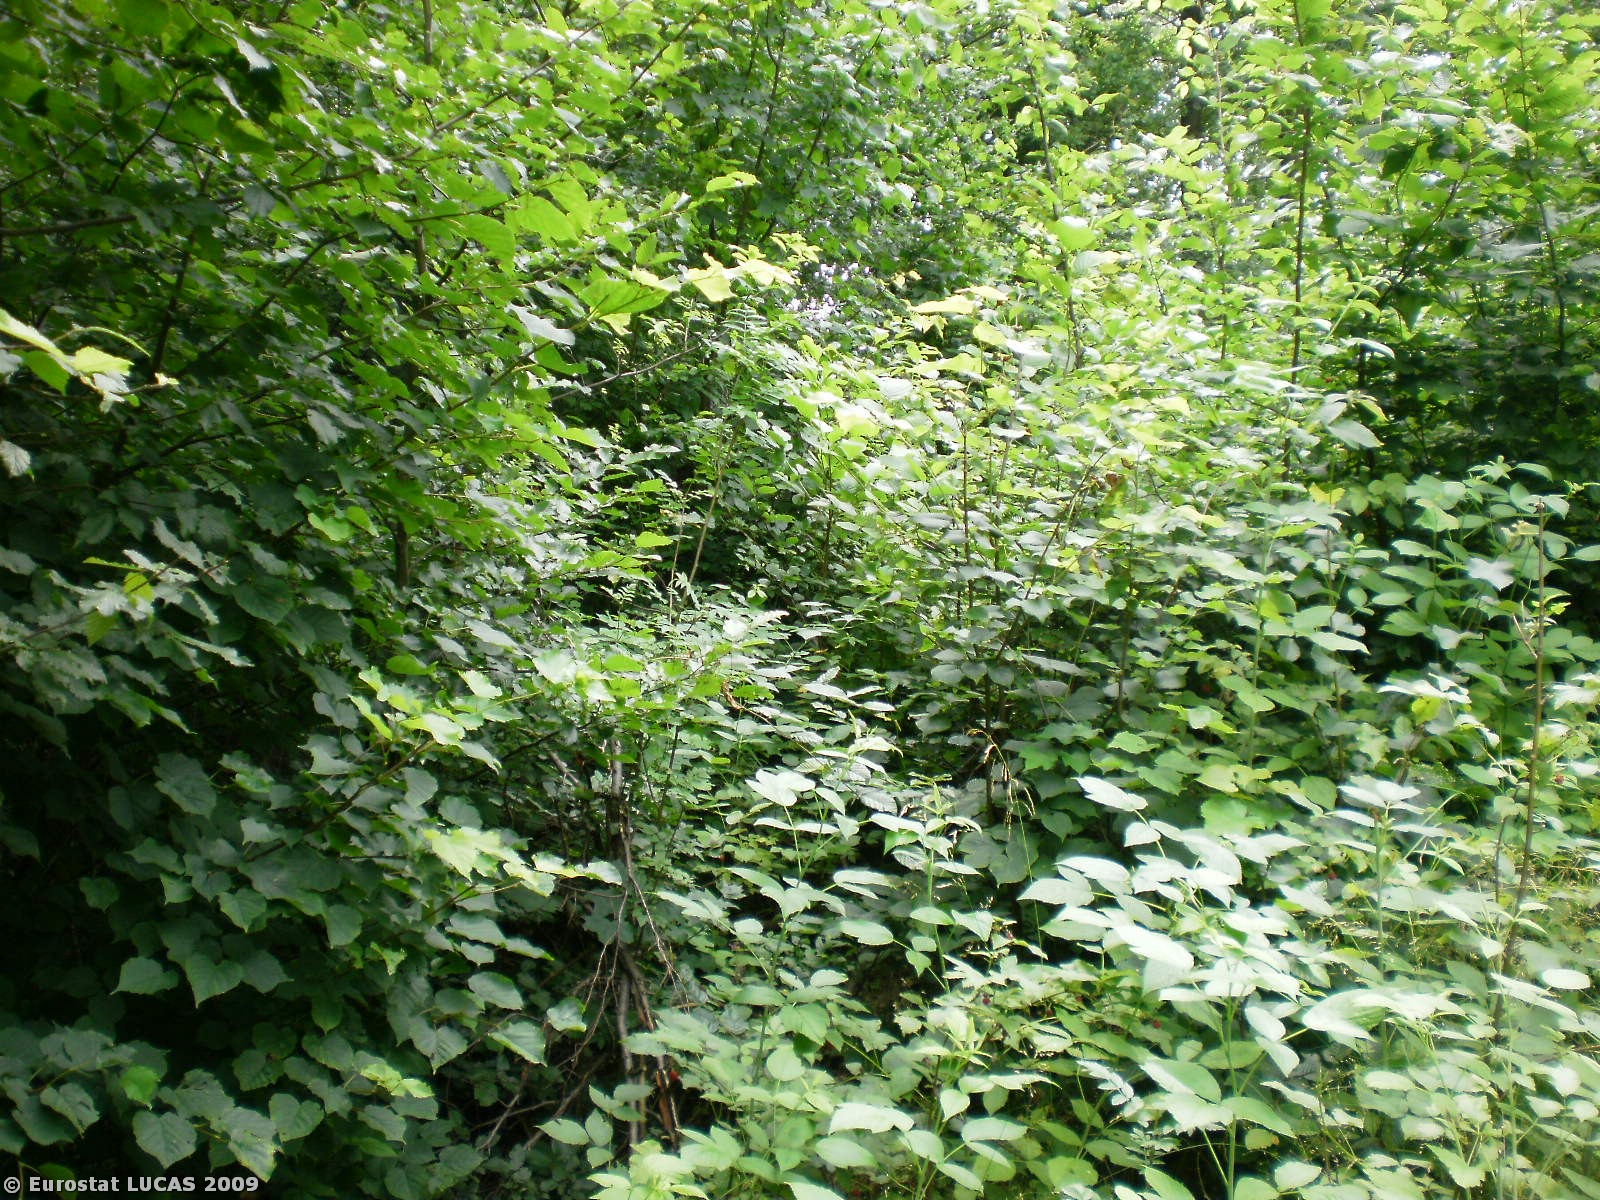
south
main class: Woodland
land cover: Broadleaved woodland
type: mesophytic deciduous forest
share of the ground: 50 - 75 %
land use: Unused
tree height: > 5 m
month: July
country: PL
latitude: 54.0784
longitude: 19.9499
